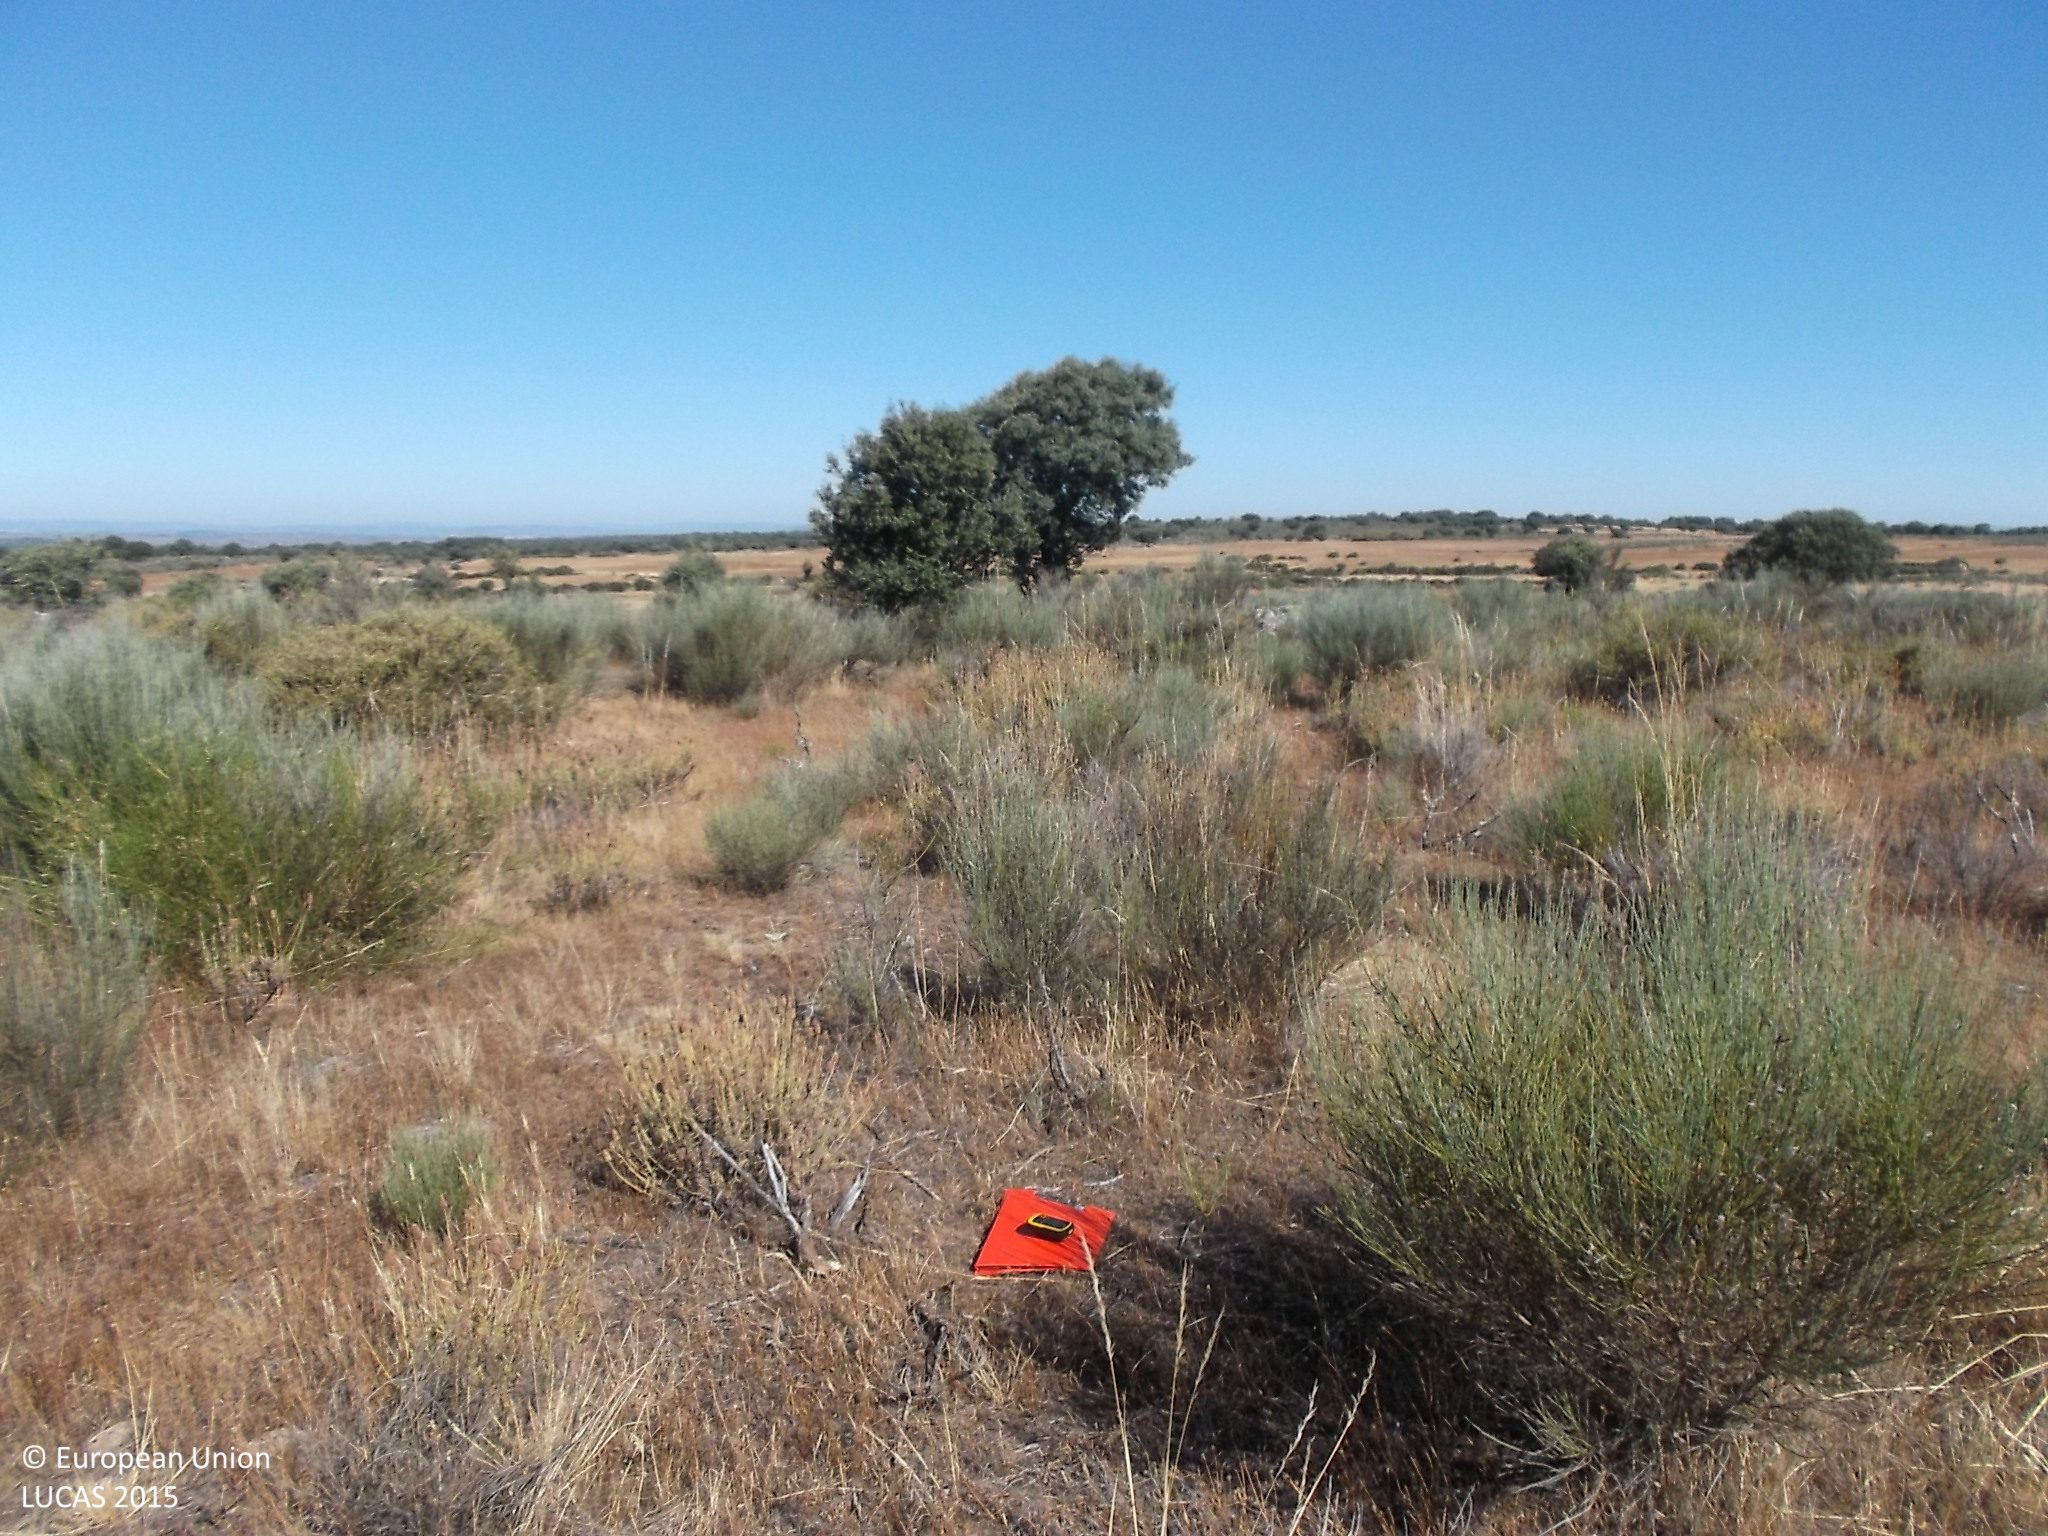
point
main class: Shrubland
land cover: Shrubland without tree cover
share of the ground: > 75 %
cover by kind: shrubs 70 %, herbaceous plants 30 %
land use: Agriculture (excluding fallow land and kitchen gardens)
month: June
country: ES
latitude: 40.9323
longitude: -6.7627
